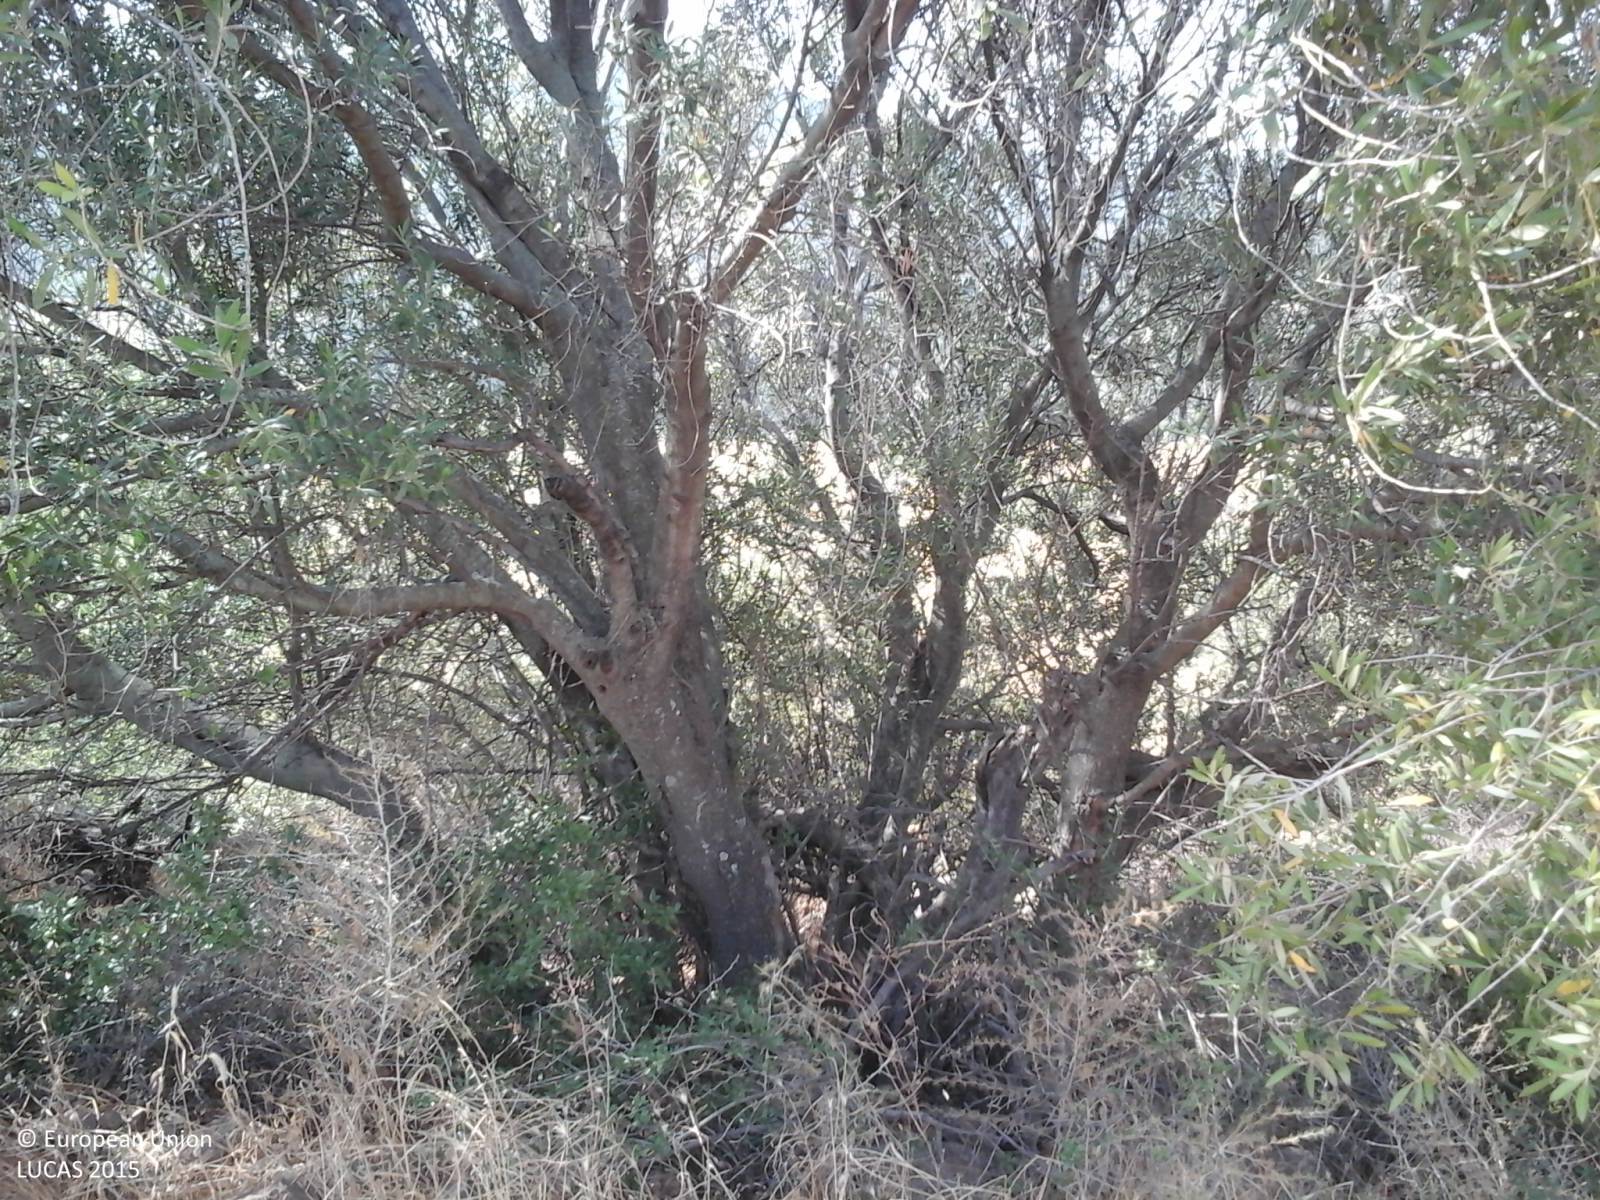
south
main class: Woodland
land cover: Broadleaved woodland
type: broadleaved evergreen forest
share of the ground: > 75 %
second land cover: Temporary grasslands
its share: > 75 %
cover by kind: broadleaved forest trees 95 %, herbaceous plants 5 %
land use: Forestry
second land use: Agriculture (excluding fallow land and kitchen gardens)
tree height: > 5 m
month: July
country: IT
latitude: 40.6283
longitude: 9.5647
